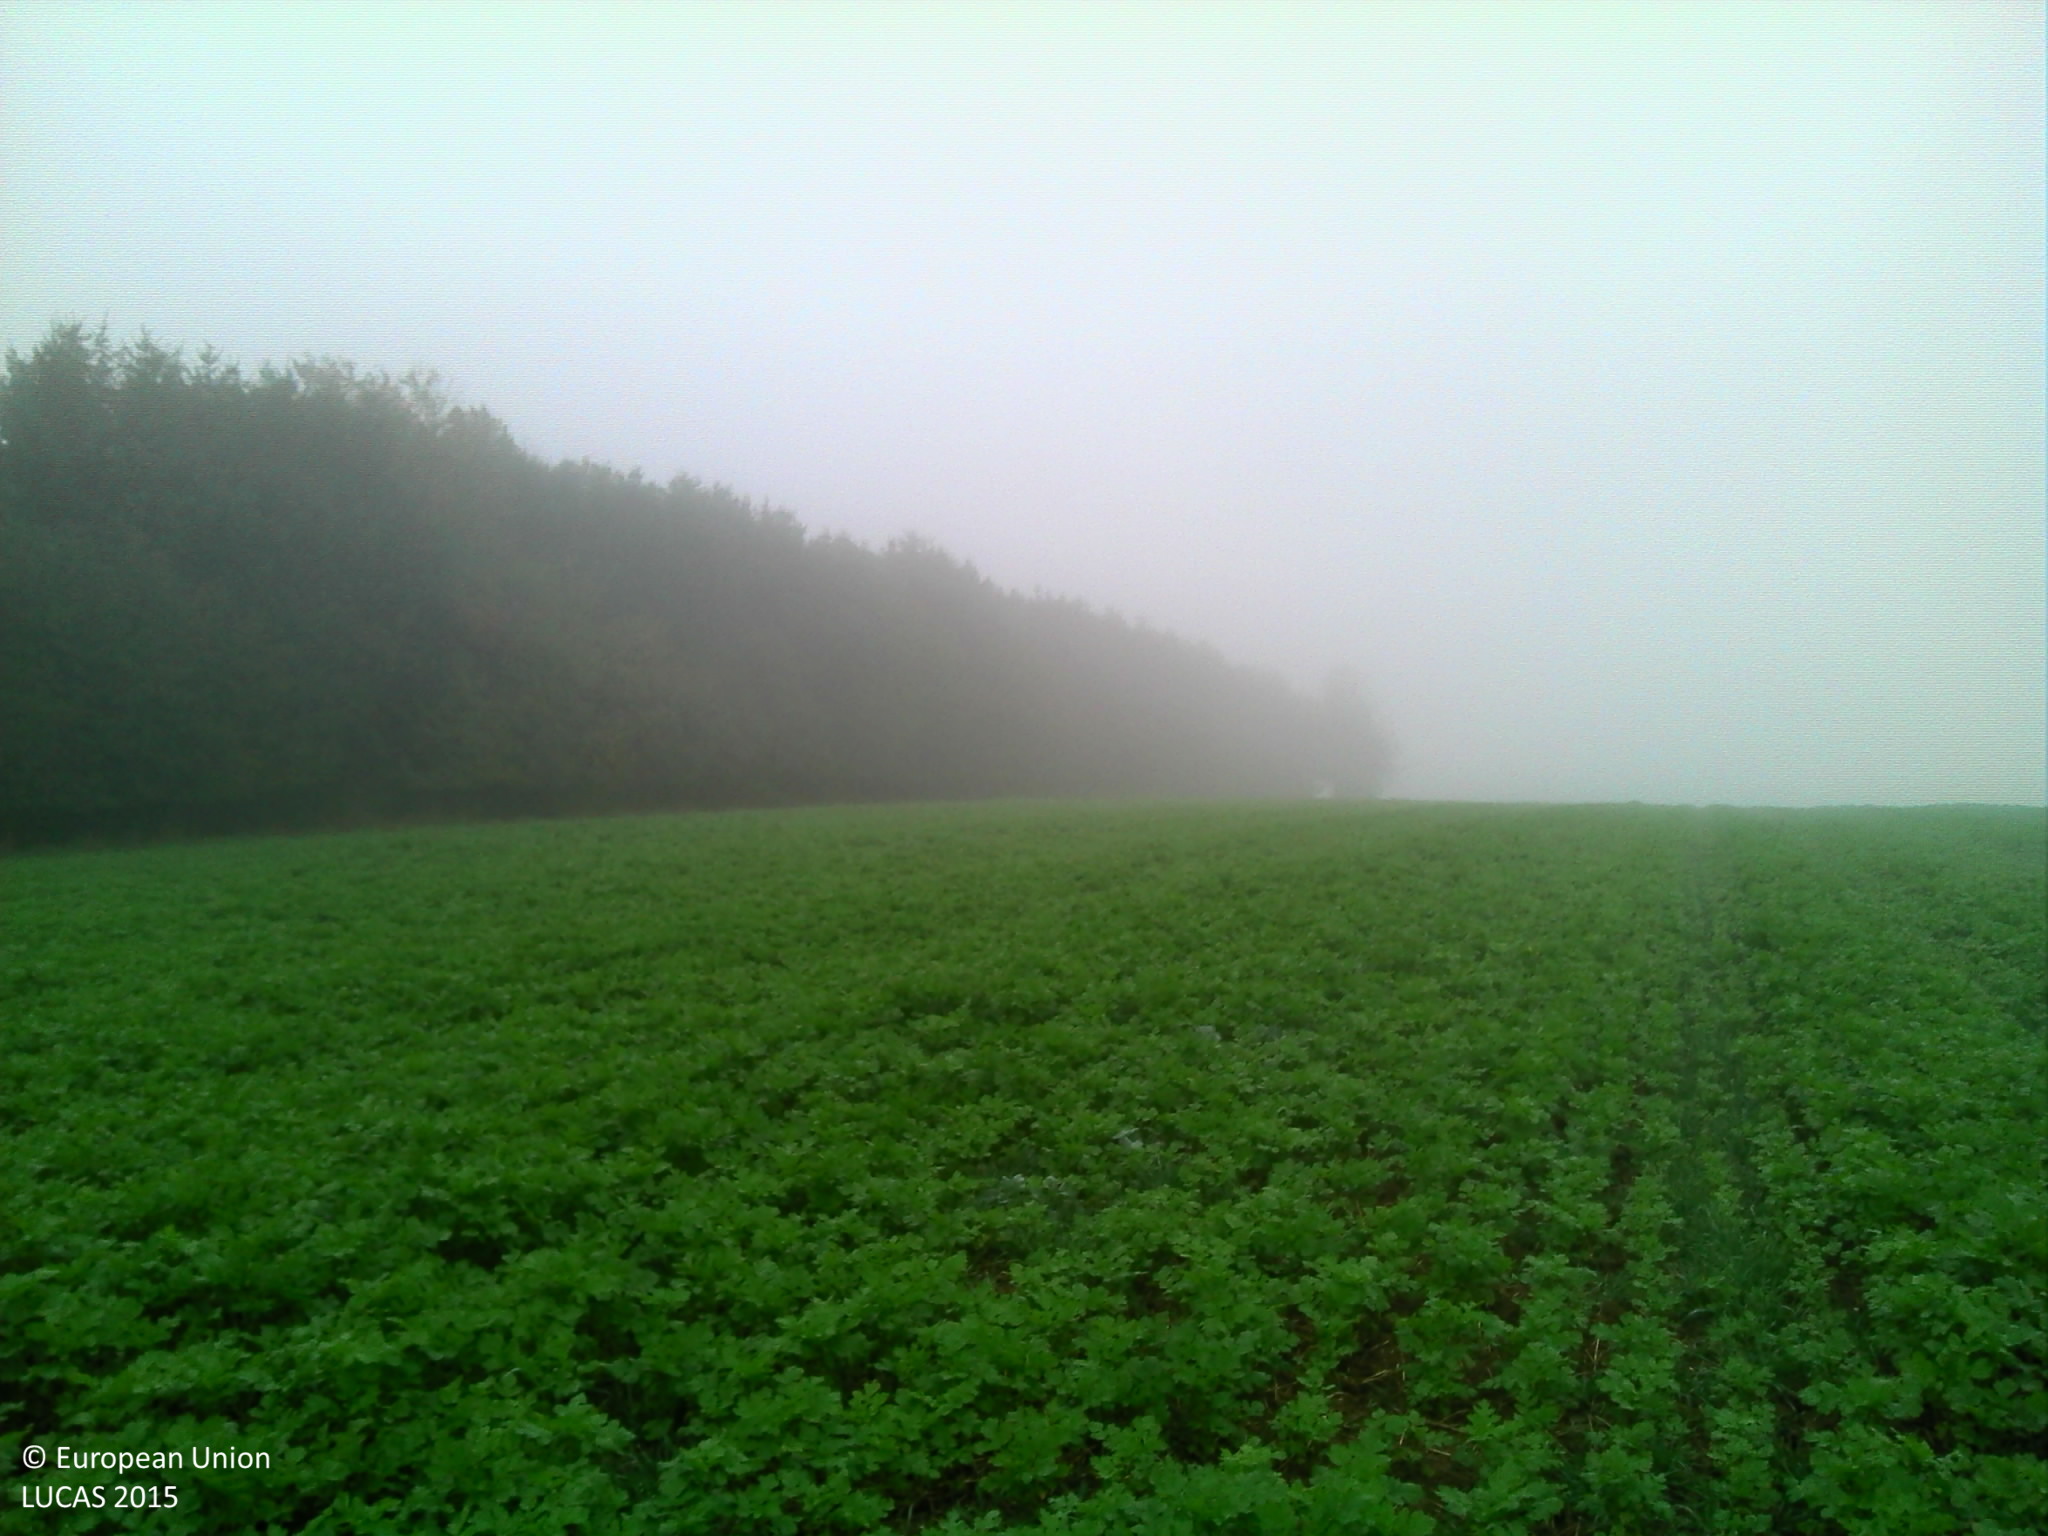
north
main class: Cropland
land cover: Other fibre and oleaginous crops
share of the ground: > 75 %
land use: Agriculture (excluding fallow land and kitchen gardens)
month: October
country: FR
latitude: 49.7951
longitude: 4.0629
